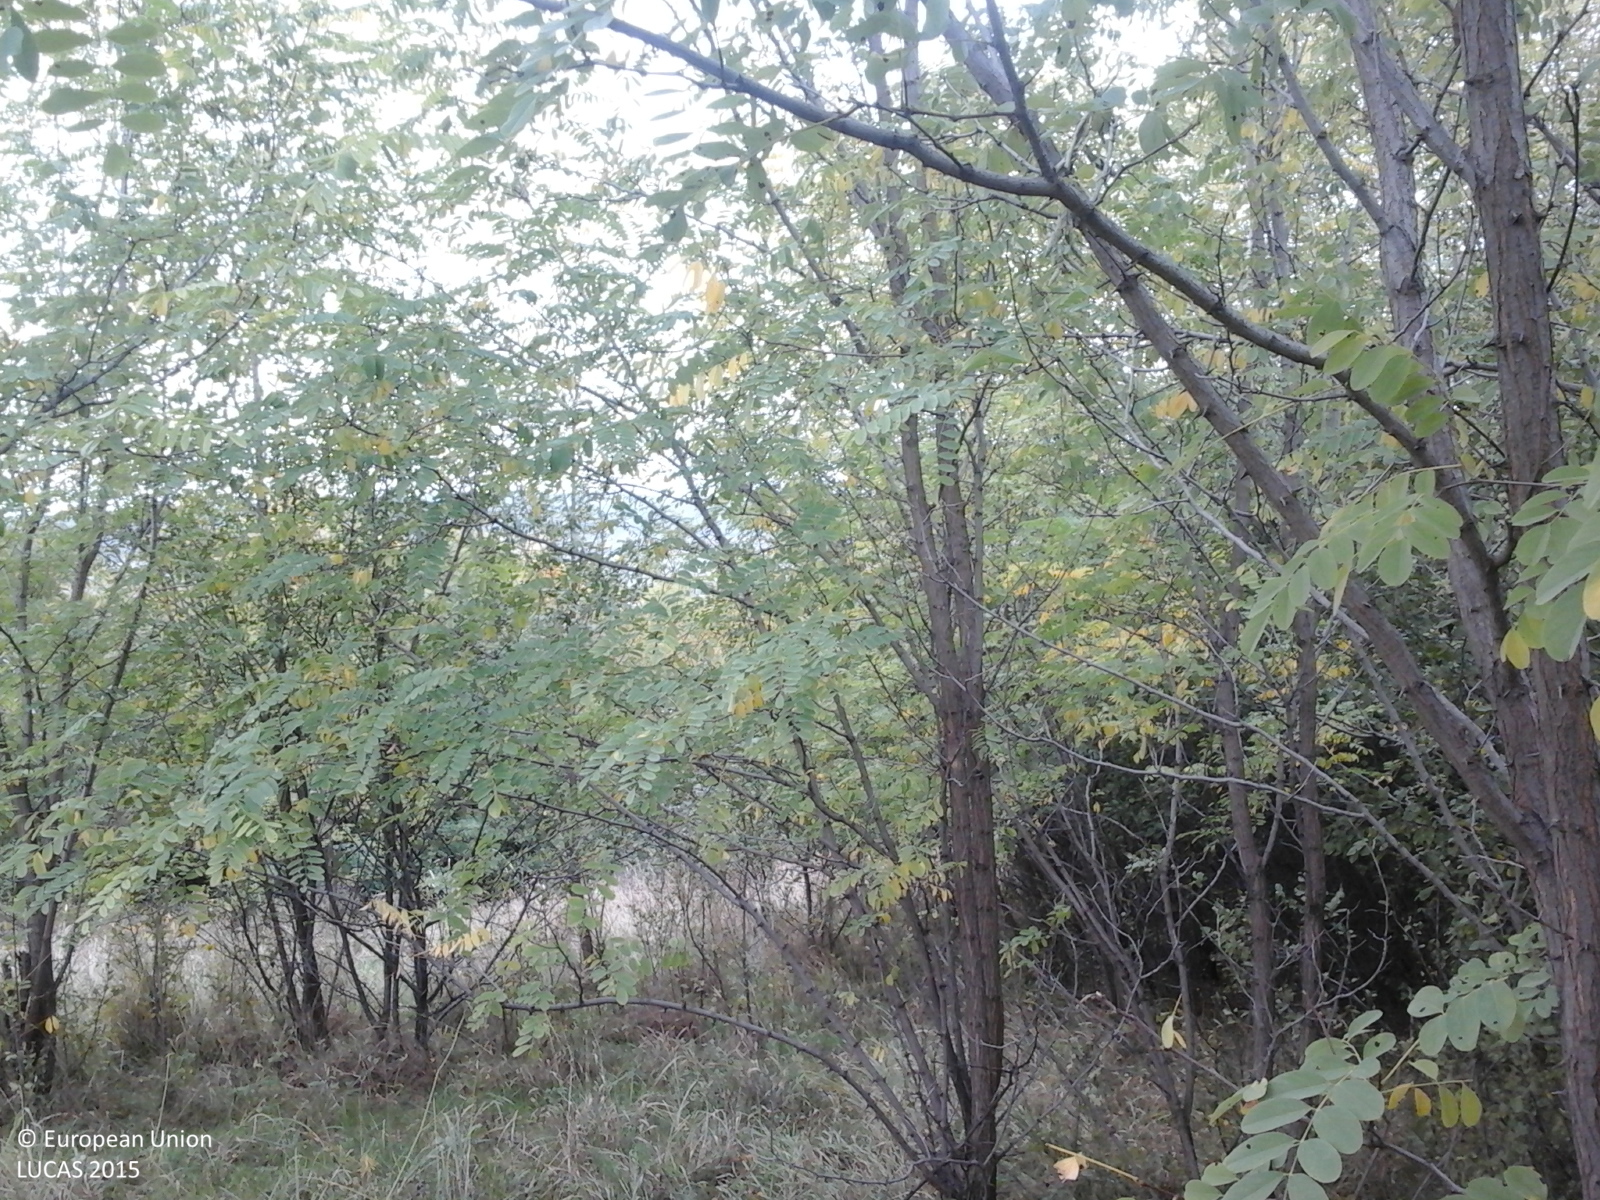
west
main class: Woodland
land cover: Broadleaved woodland
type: exotic forest
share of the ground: > 75 %
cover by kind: broadleaved forest trees 100 %
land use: Forestry
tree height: > 5 m
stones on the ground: < 10 %
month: October
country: RO
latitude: 45.0388
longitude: 26.0411
